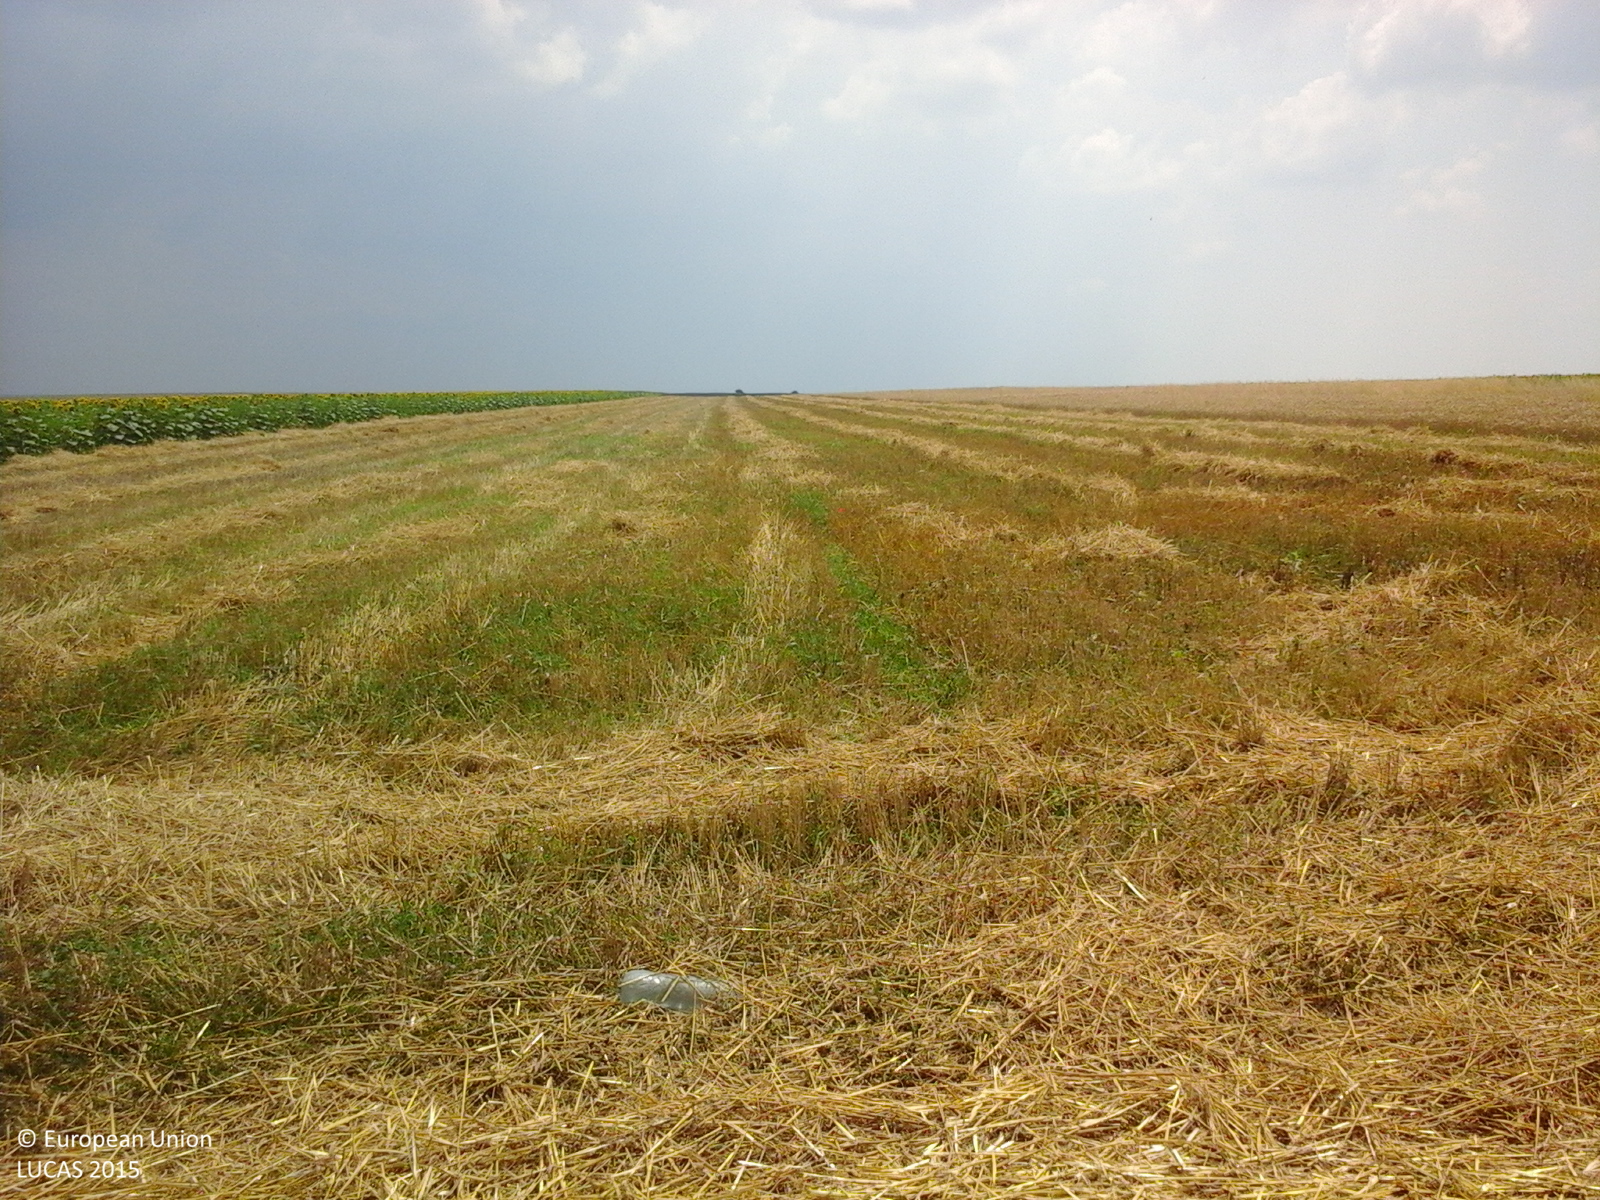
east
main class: Cropland
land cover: Maize
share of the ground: > 75 %
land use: Agriculture (excluding fallow land and kitchen gardens)
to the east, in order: Maize
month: July
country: RO
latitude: 43.8054
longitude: 25.1047
